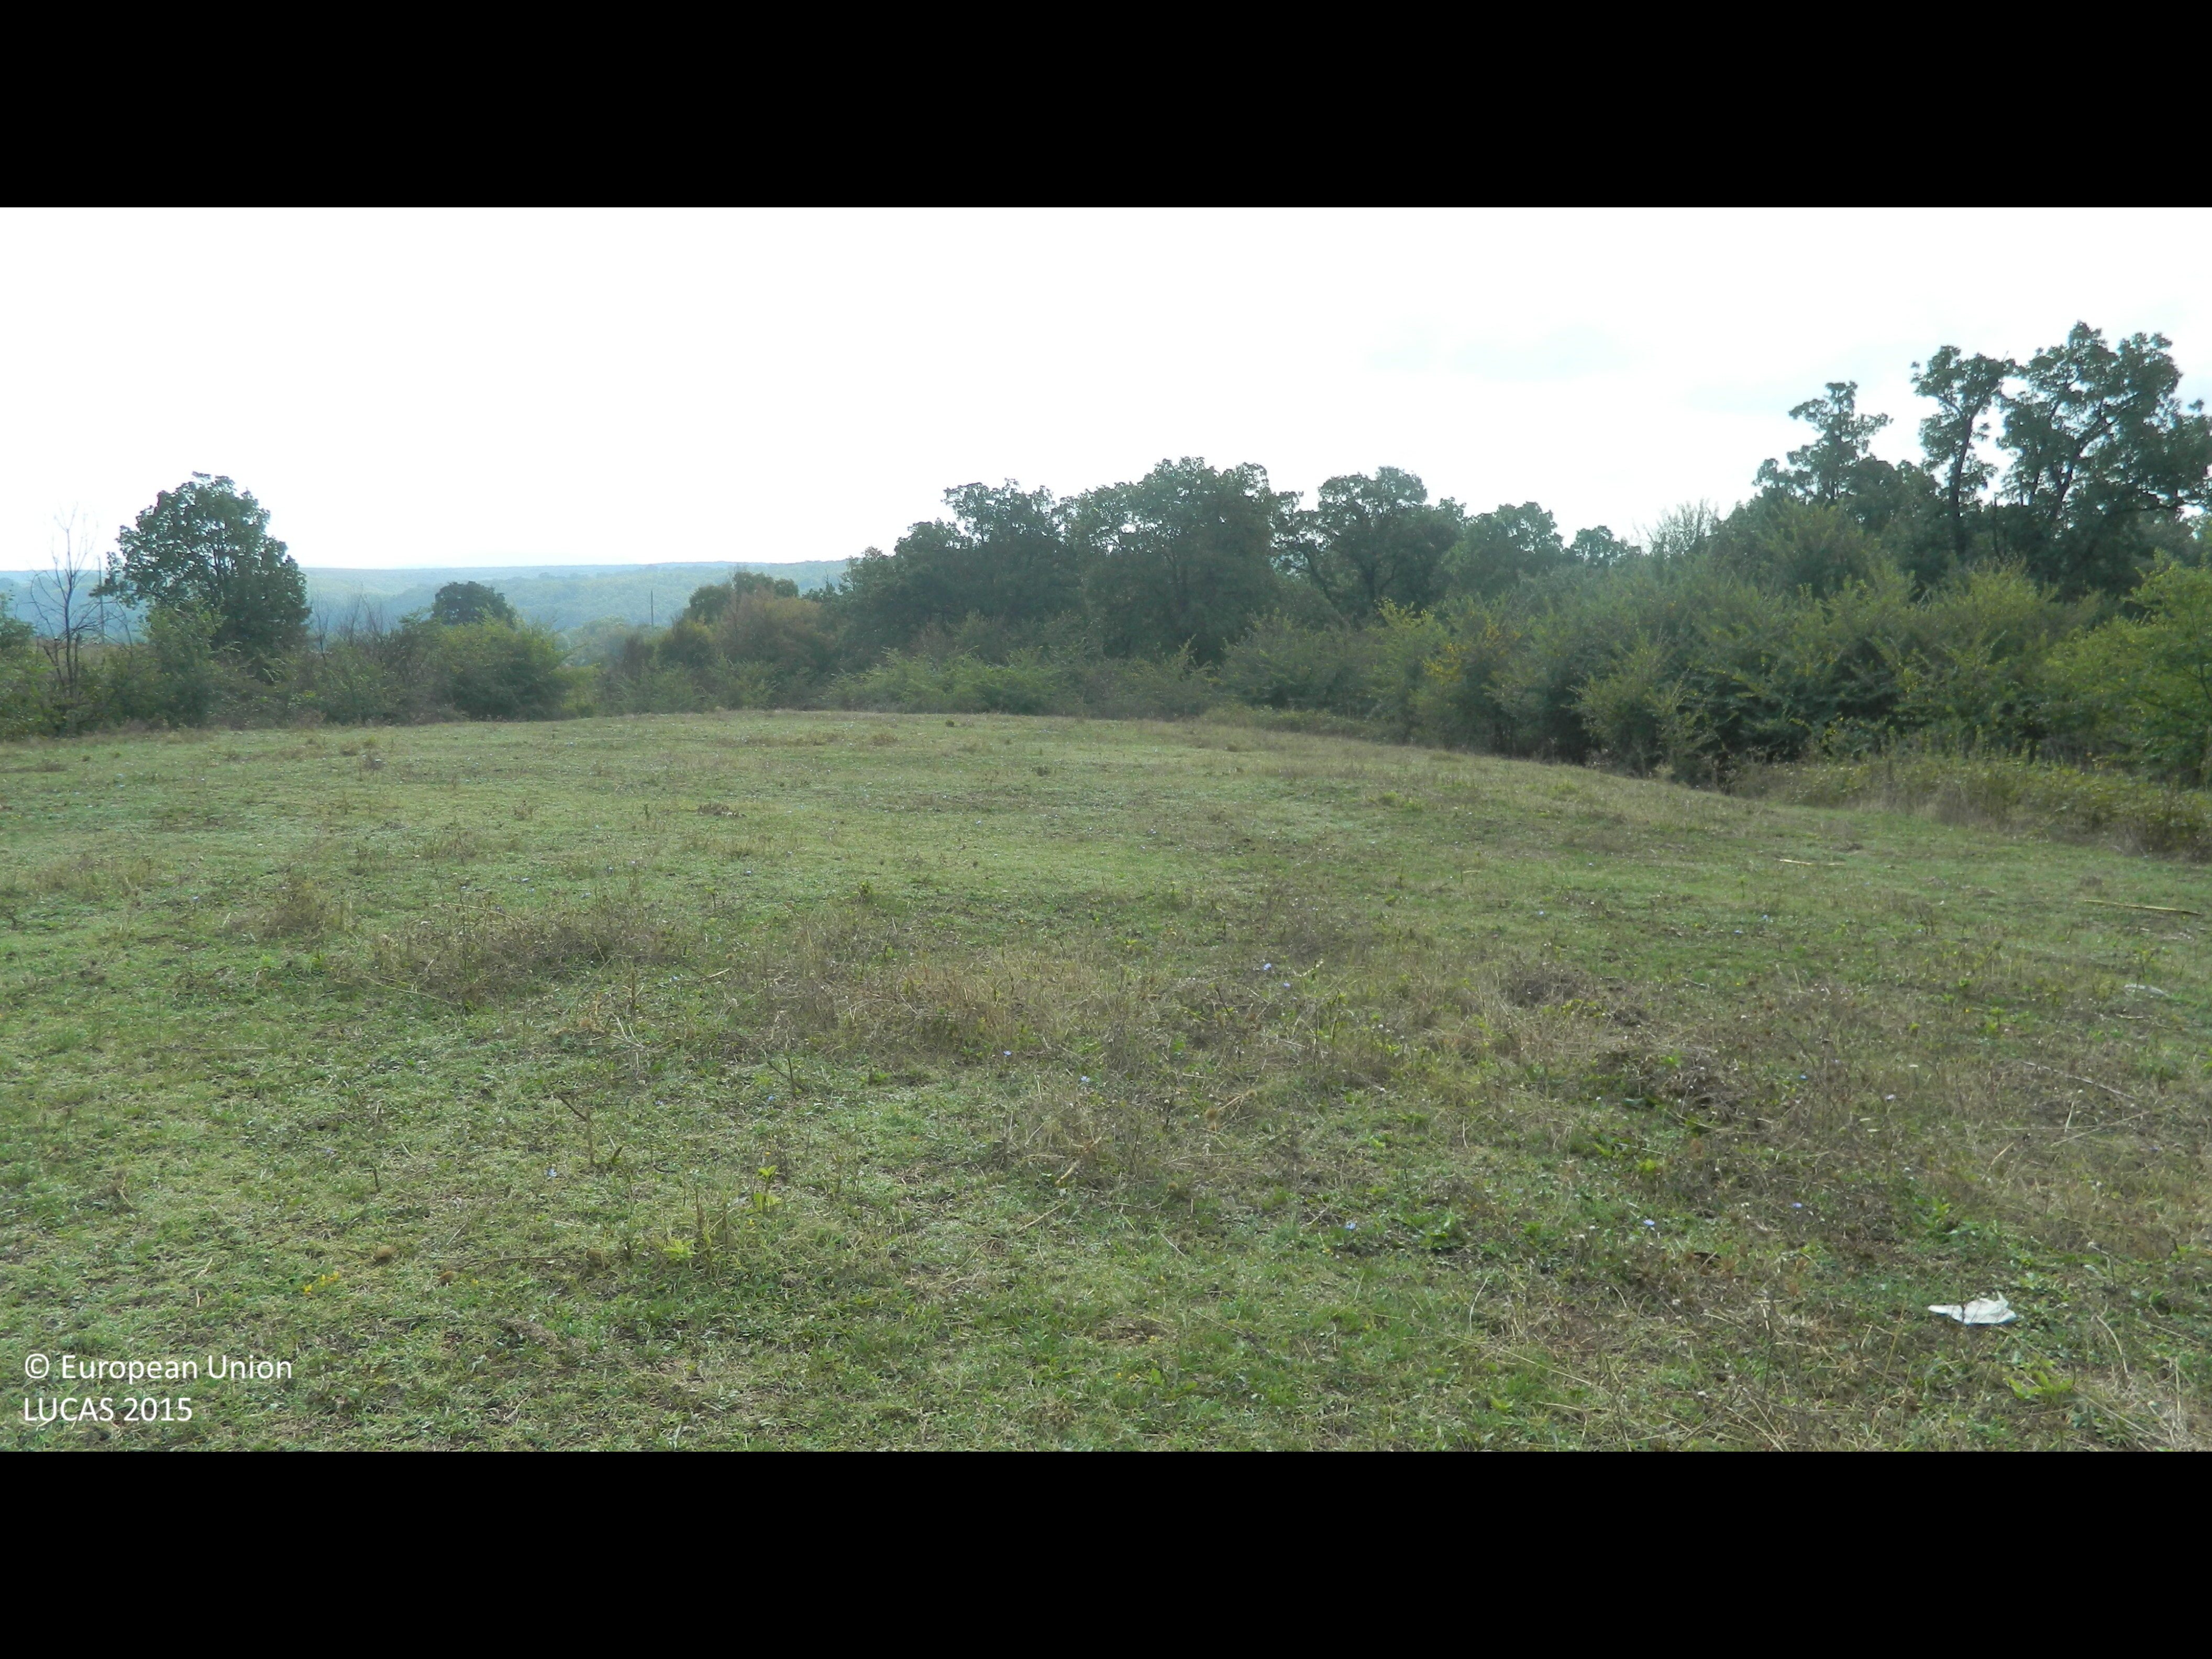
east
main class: Grassland
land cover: Grassland without tree/shrub cover
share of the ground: > 75 %
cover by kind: herbaceous plants 100 %
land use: Agriculture (excluding fallow land and kitchen gardens)
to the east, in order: Grassland without tree/shrub cover; Broadleaved woodland; Grassland without tree/shrub cover
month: September
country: BG
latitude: 41.8249
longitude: 25.5828
